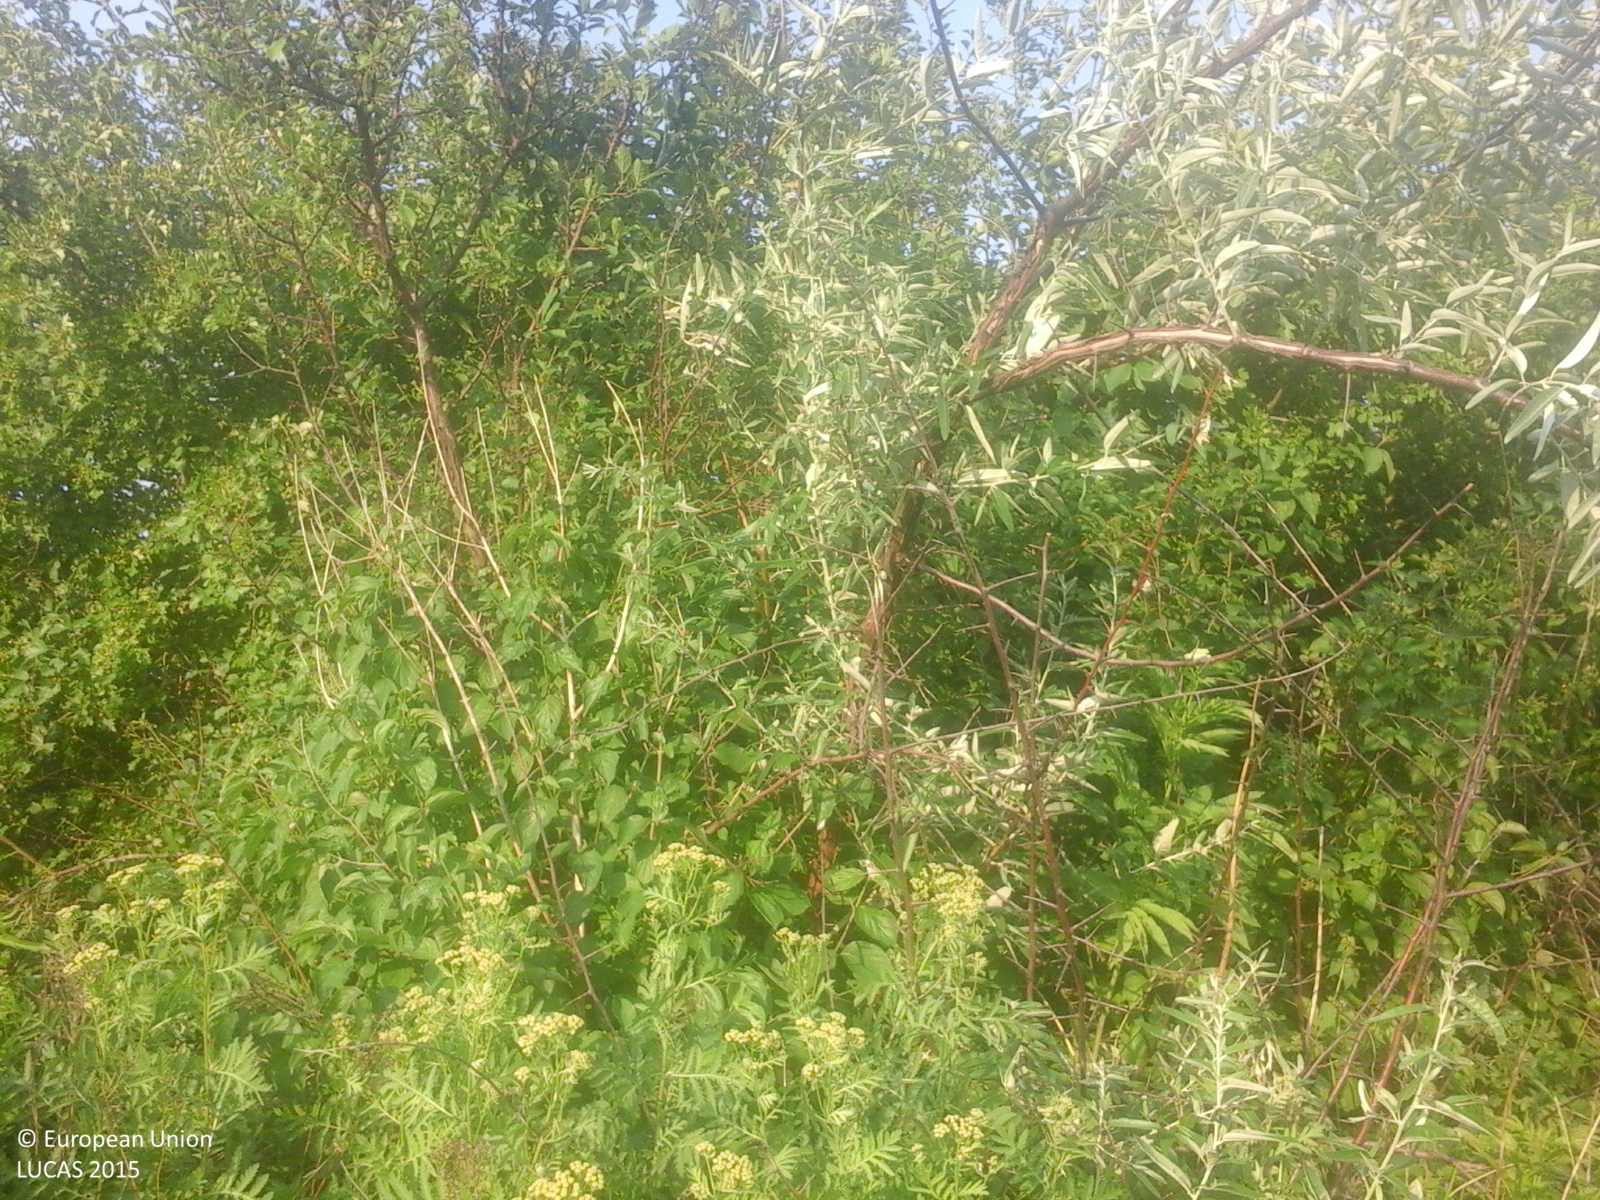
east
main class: Shrubland
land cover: Shrubland with sparse tree cover
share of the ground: > 75 %
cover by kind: shrubs 95 %, broadleaved forest trees 5 %
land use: Semi-natural and natural areas not in use
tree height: < 5 m
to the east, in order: Shrubland with sparse tree cover; Grassland with sparse tree/shrub cover; Shrubland with sparse tree cover; Grassland with sparse tree/shrub cover
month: June
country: RO
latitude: 46.7442
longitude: 27.7782
